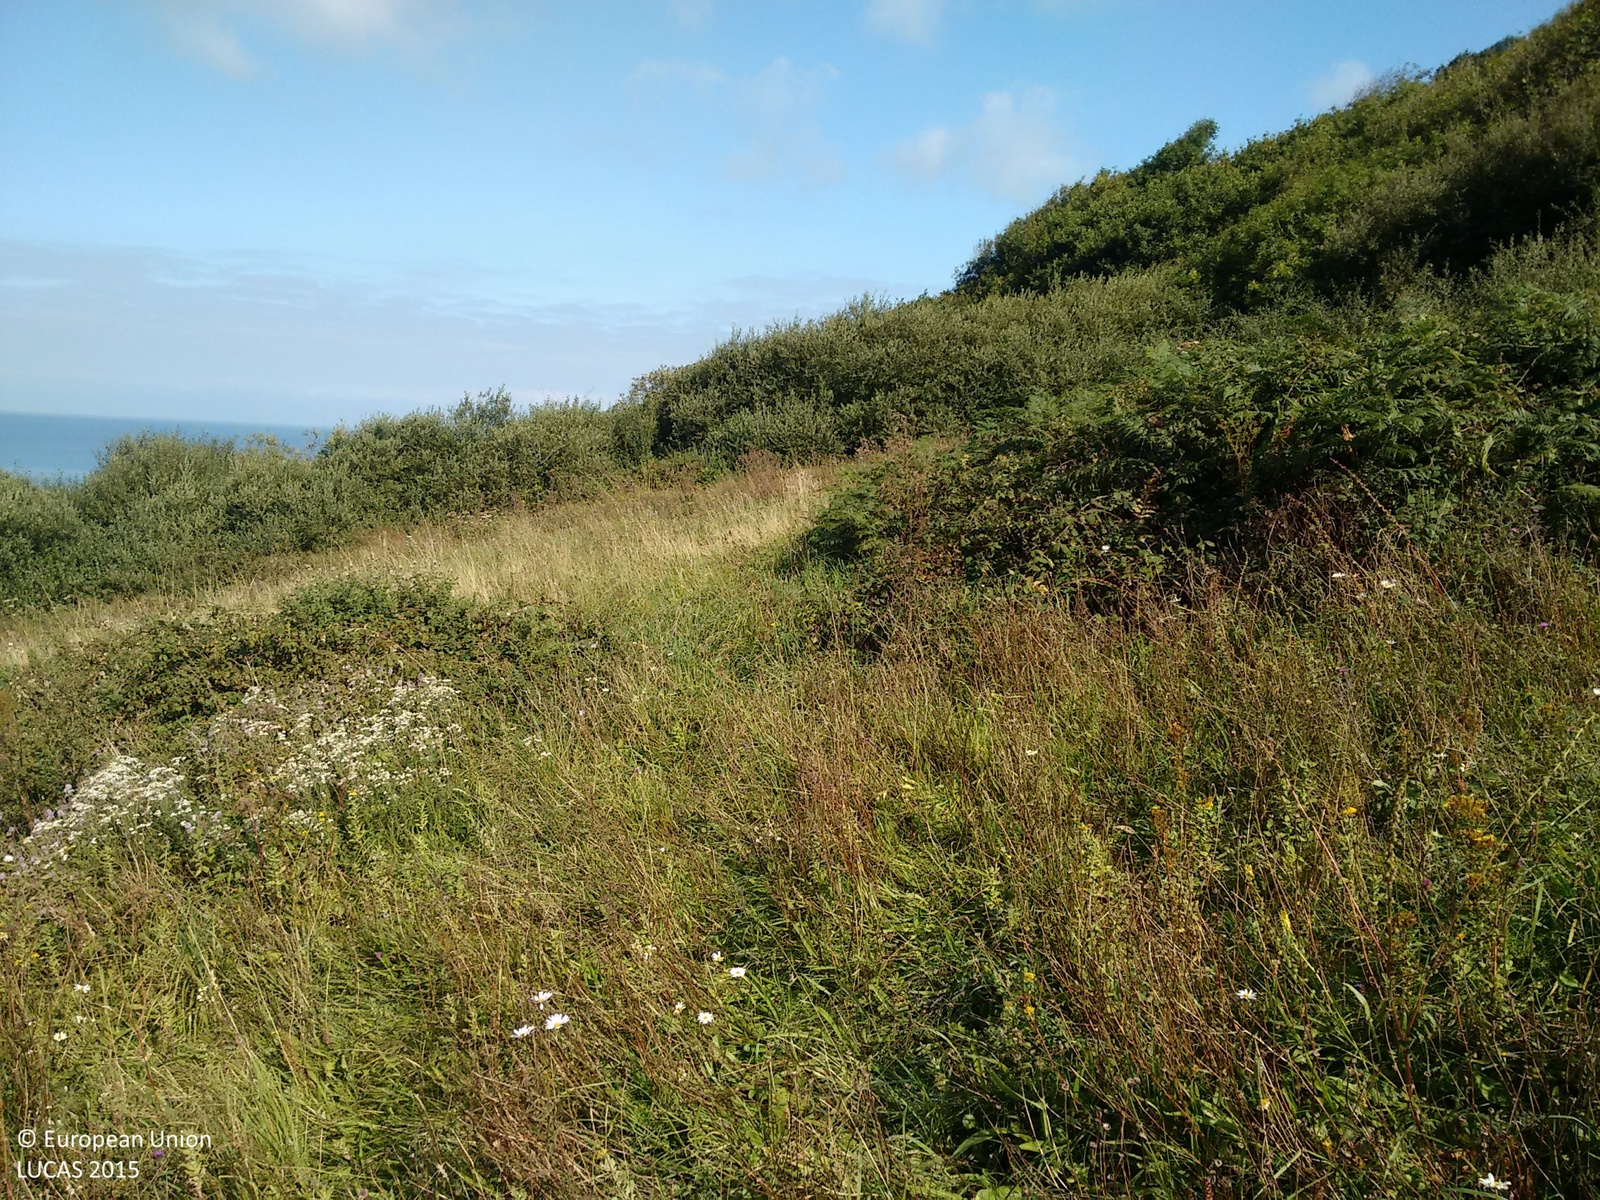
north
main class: Grassland
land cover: Grassland without tree/shrub cover
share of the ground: > 75 %
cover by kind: herbaceous plants 100 %
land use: Agriculture (excluding fallow land and kitchen gardens)
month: September
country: GB
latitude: 50.9933
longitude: -4.3056
